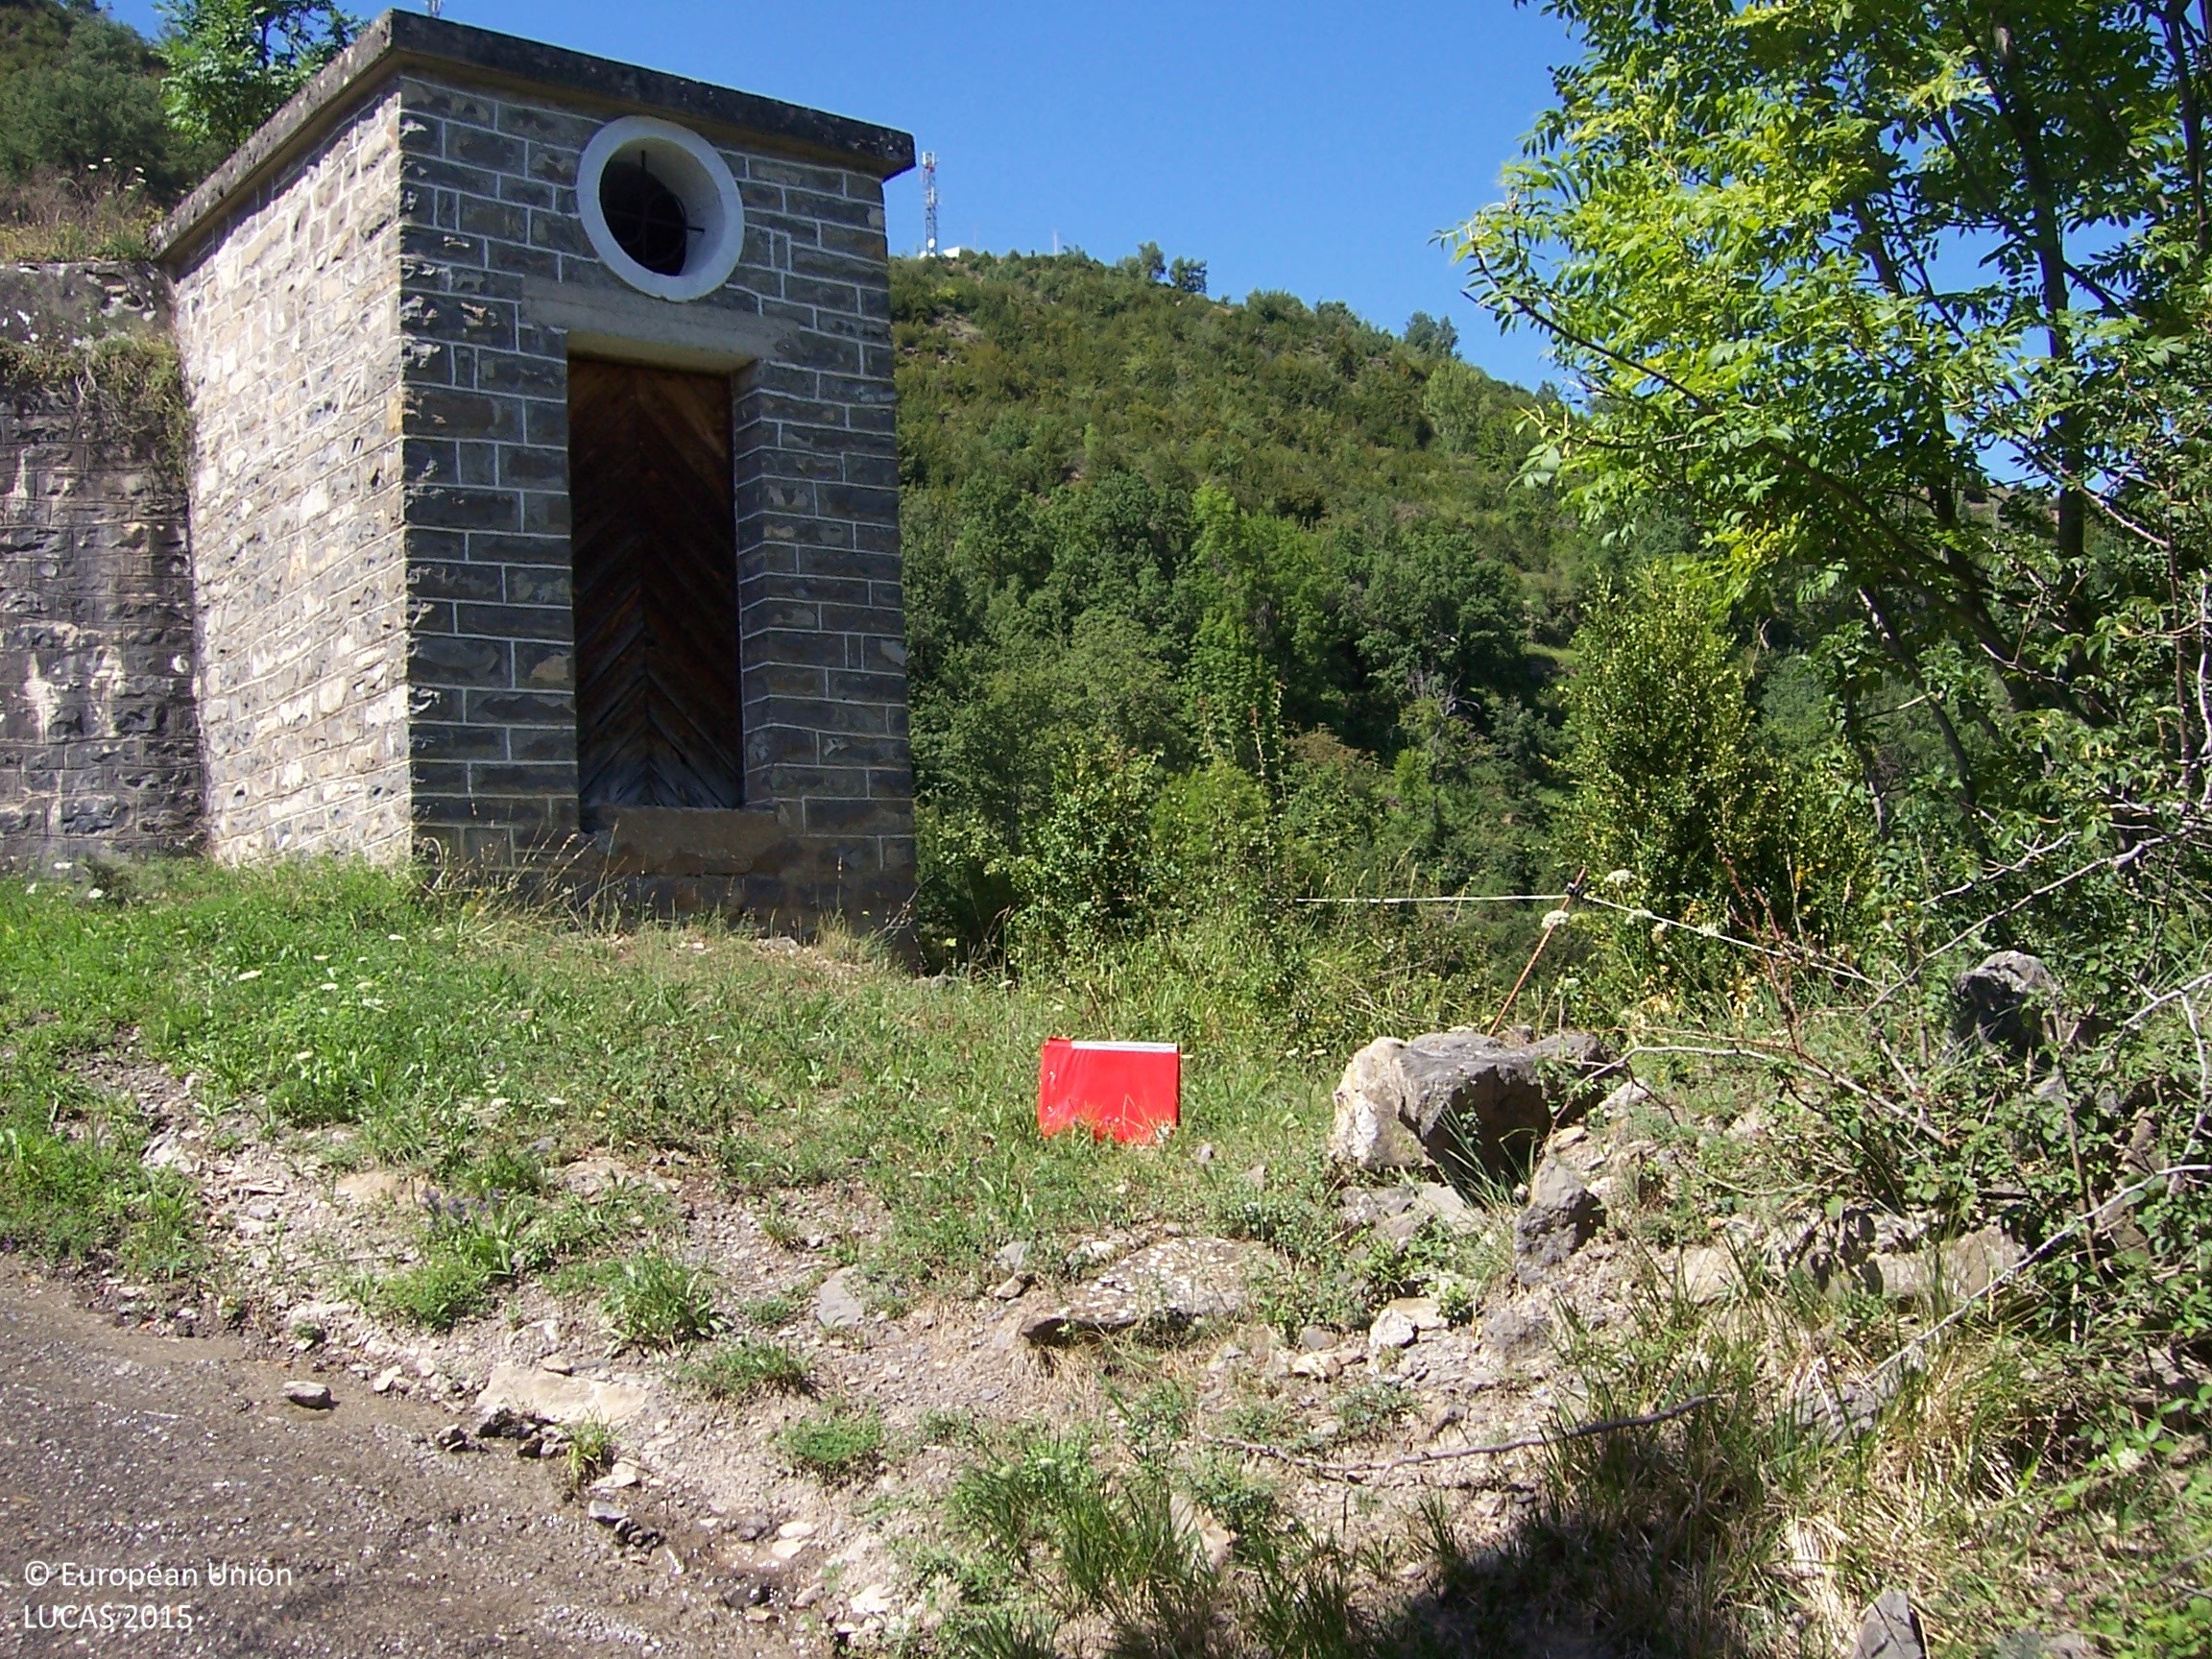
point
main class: Grassland
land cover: Grassland with sparse tree/shrub cover
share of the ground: > 75 %
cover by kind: herbaceous plants 95 %, broadleaved forest trees 5 %
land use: Semi-natural and natural areas not in use
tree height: > 5 m
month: August
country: ES
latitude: 42.5997
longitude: -0.1281
